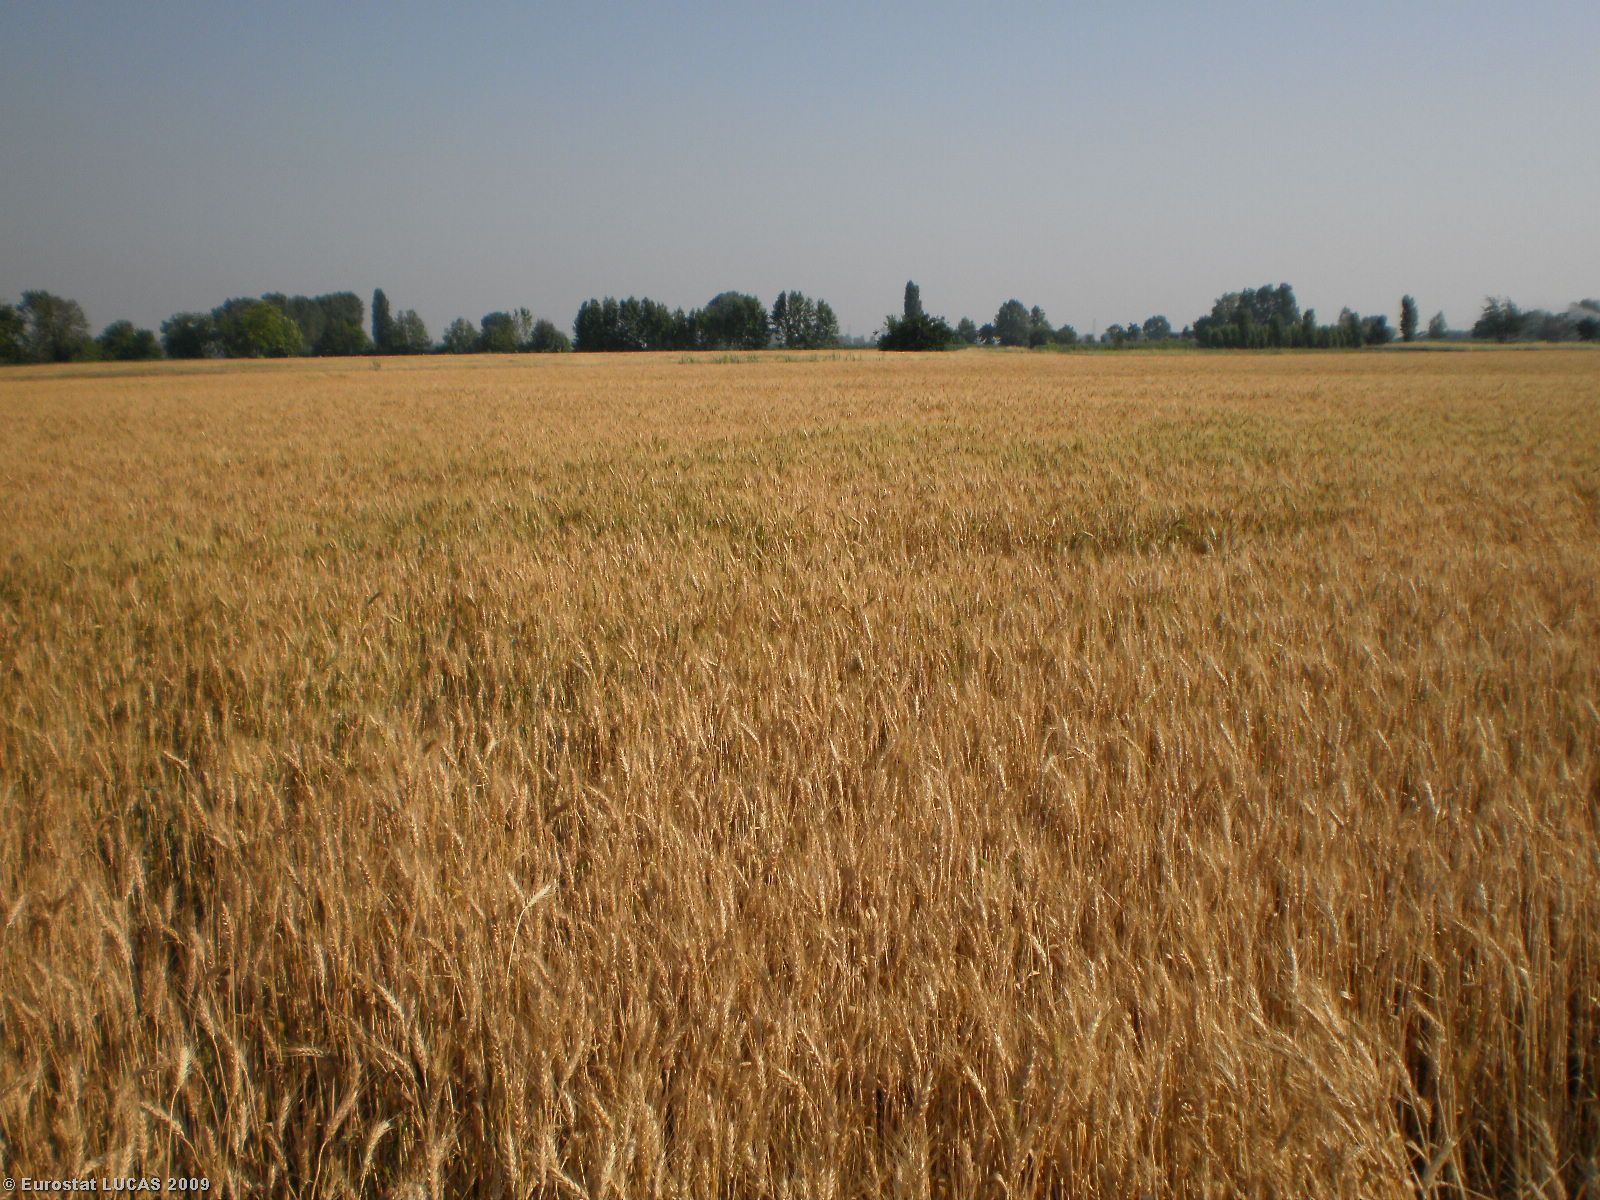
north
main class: Cropland
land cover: Common wheat
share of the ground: > 75 %
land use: Agriculture (excluding fallow land and kitchen gardens)
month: June
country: IT
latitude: 45.1790
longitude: 10.4446
